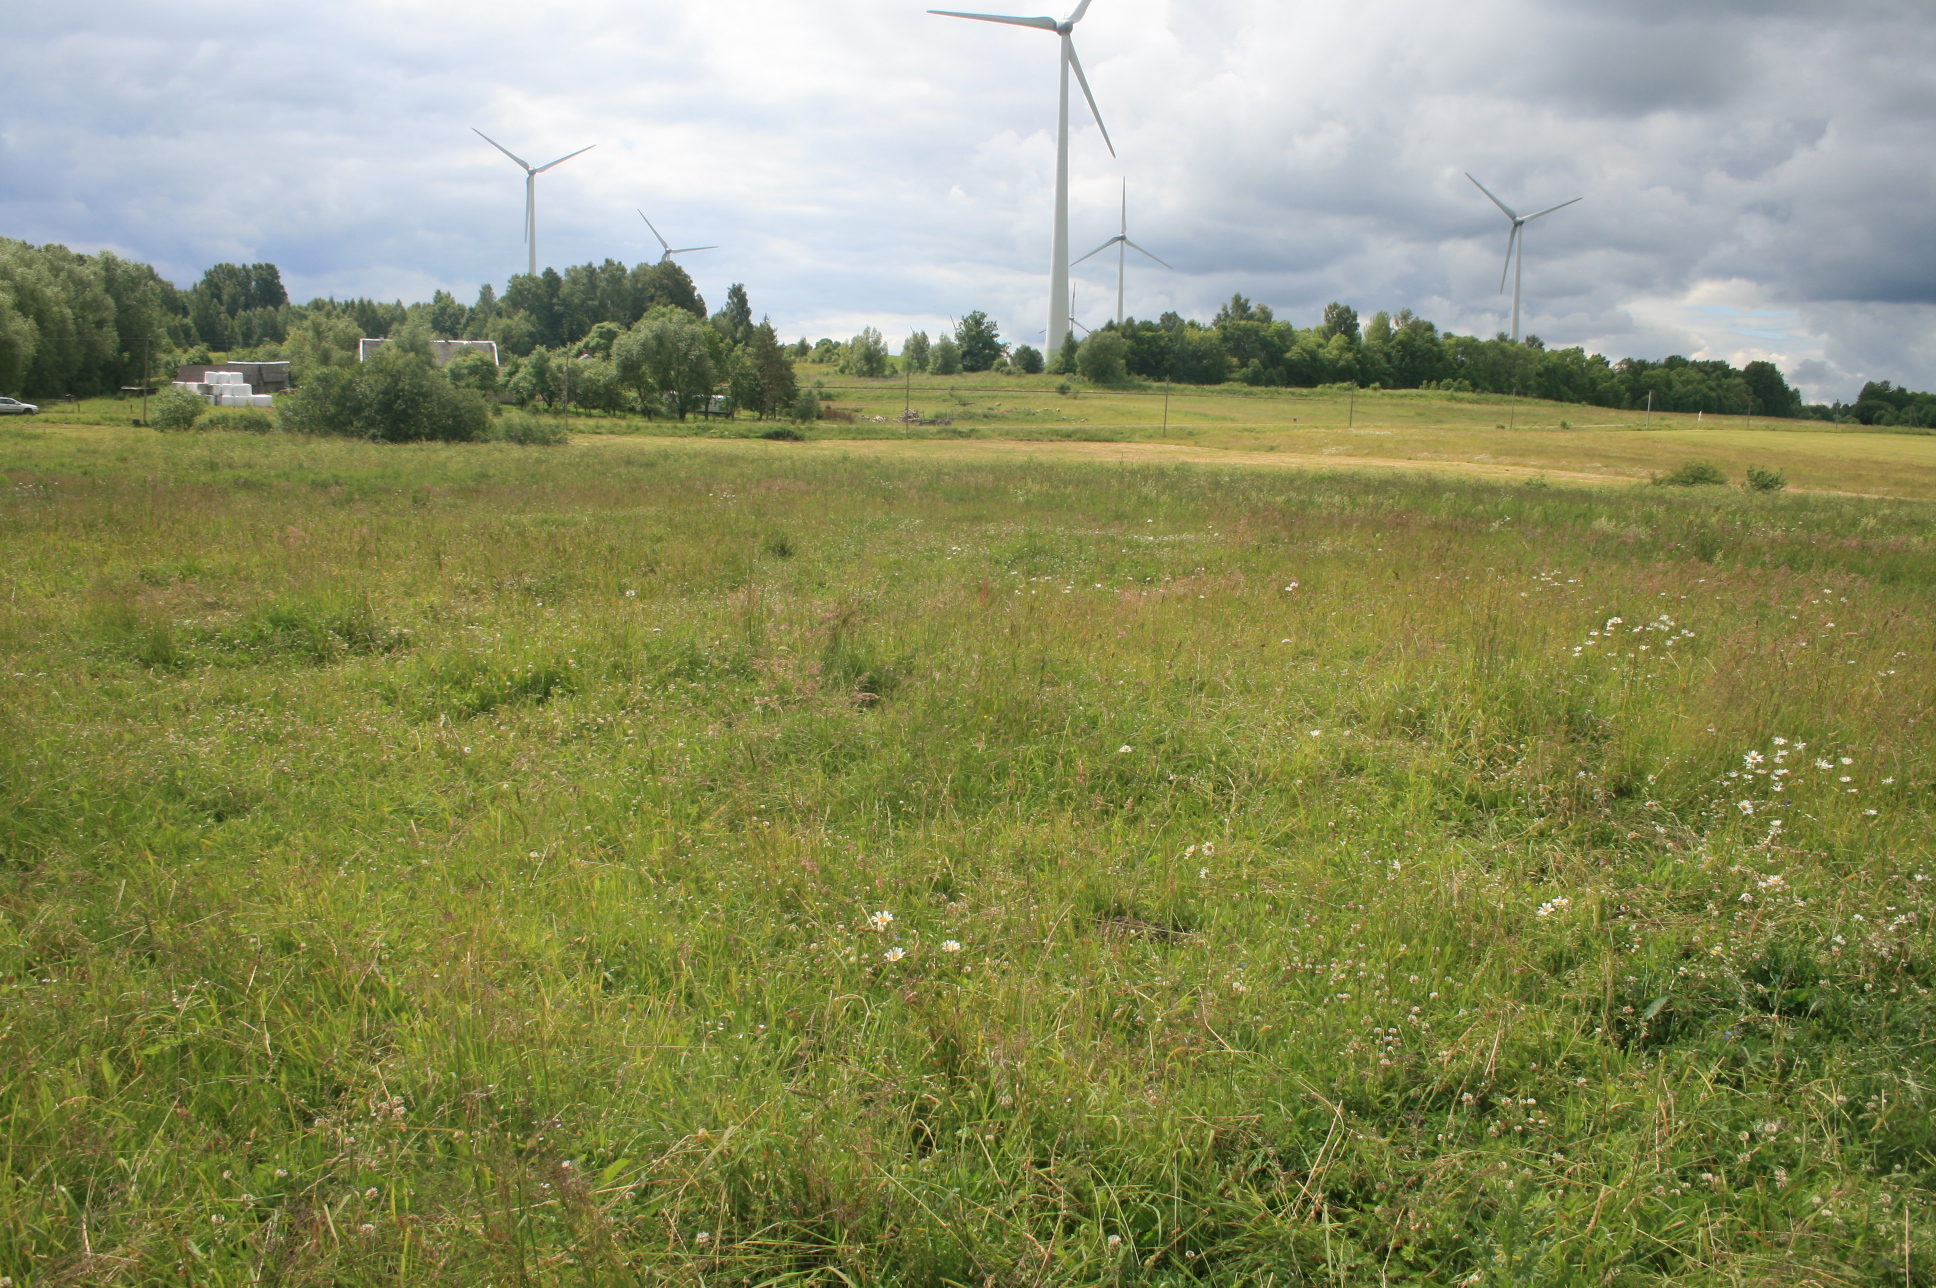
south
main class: Grassland
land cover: Grassland without tree/shrub cover
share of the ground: > 75 %
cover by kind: herbaceous plants 100 %
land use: Agriculture (excluding fallow land and kitchen gardens)
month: June
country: LT
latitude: 55.1966
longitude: 22.0733
